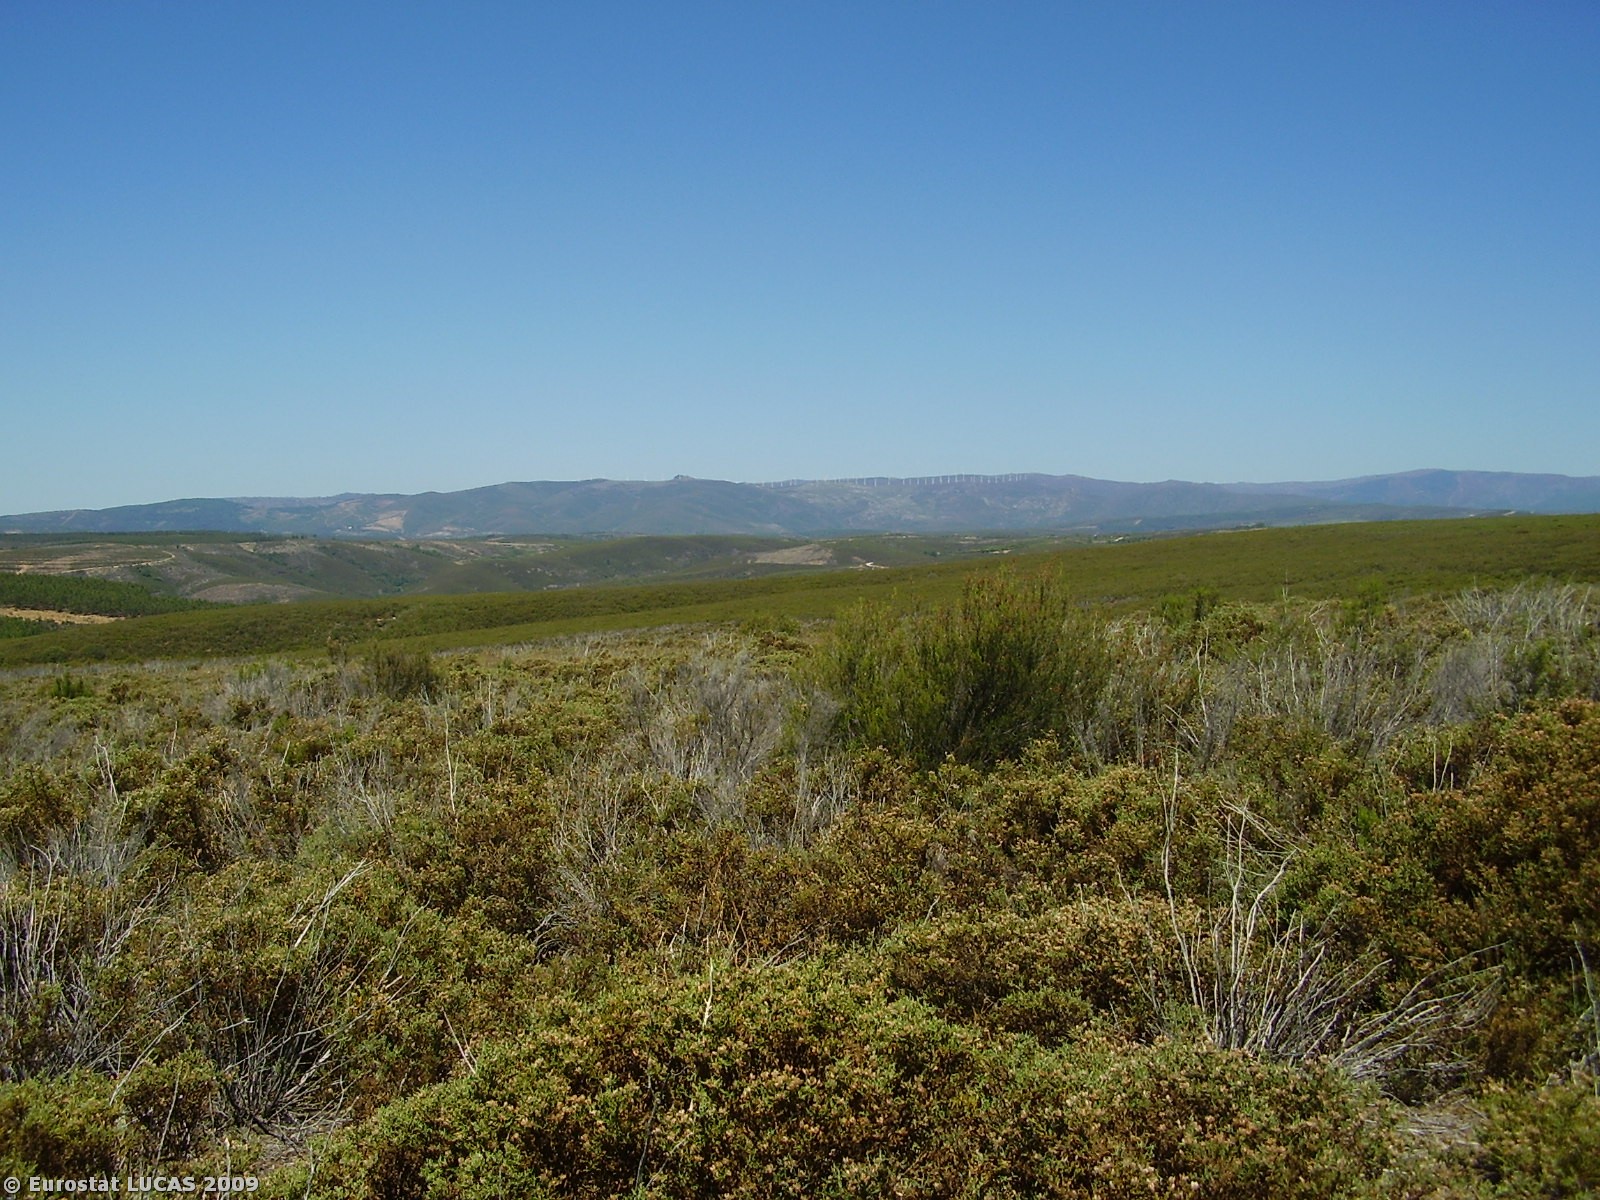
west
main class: Shrubland
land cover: Shrubland without tree cover
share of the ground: 50 - 75 %
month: June
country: PT
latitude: 41.9181
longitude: -6.5933
